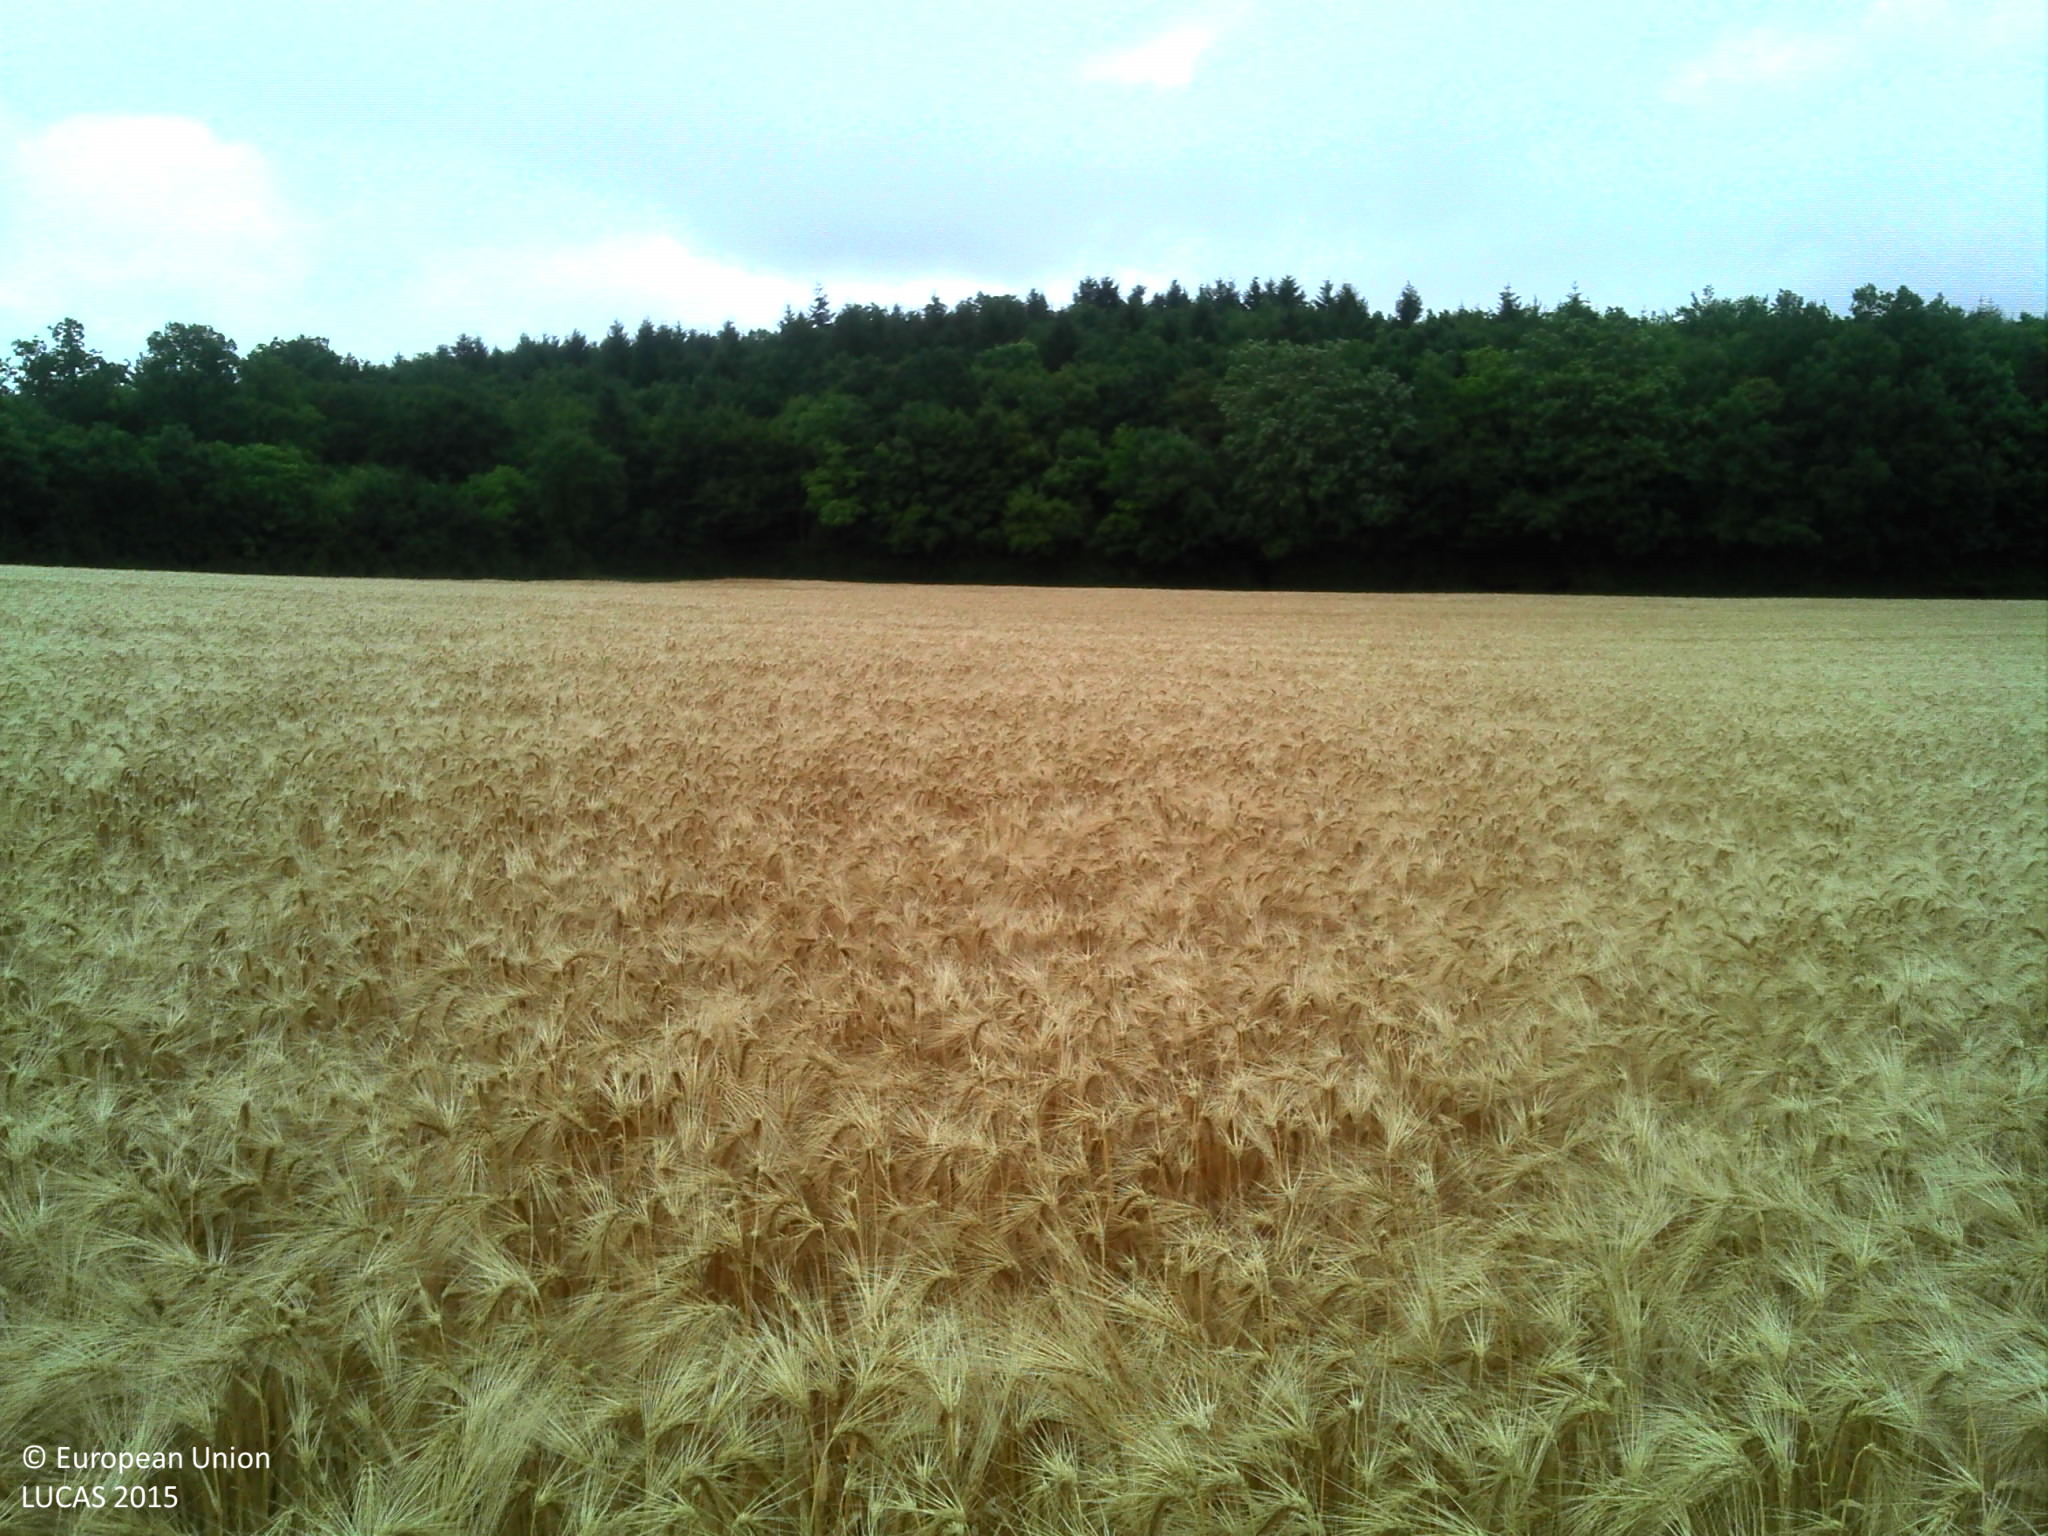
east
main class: Cropland
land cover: Barley
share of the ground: > 75 %
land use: Agriculture (excluding fallow land and kitchen gardens)
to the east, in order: Barley; Grassland without tree/shrub cover; Broadleaved woodland; Grass margins; Paved roads, cycling and walking lanes; Grass margins; Ditches and canals; Grass margins; Broadleaved woodland; Spruce dominated coniferous woodland
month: June
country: FR
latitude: 48.3194
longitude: 3.4806
